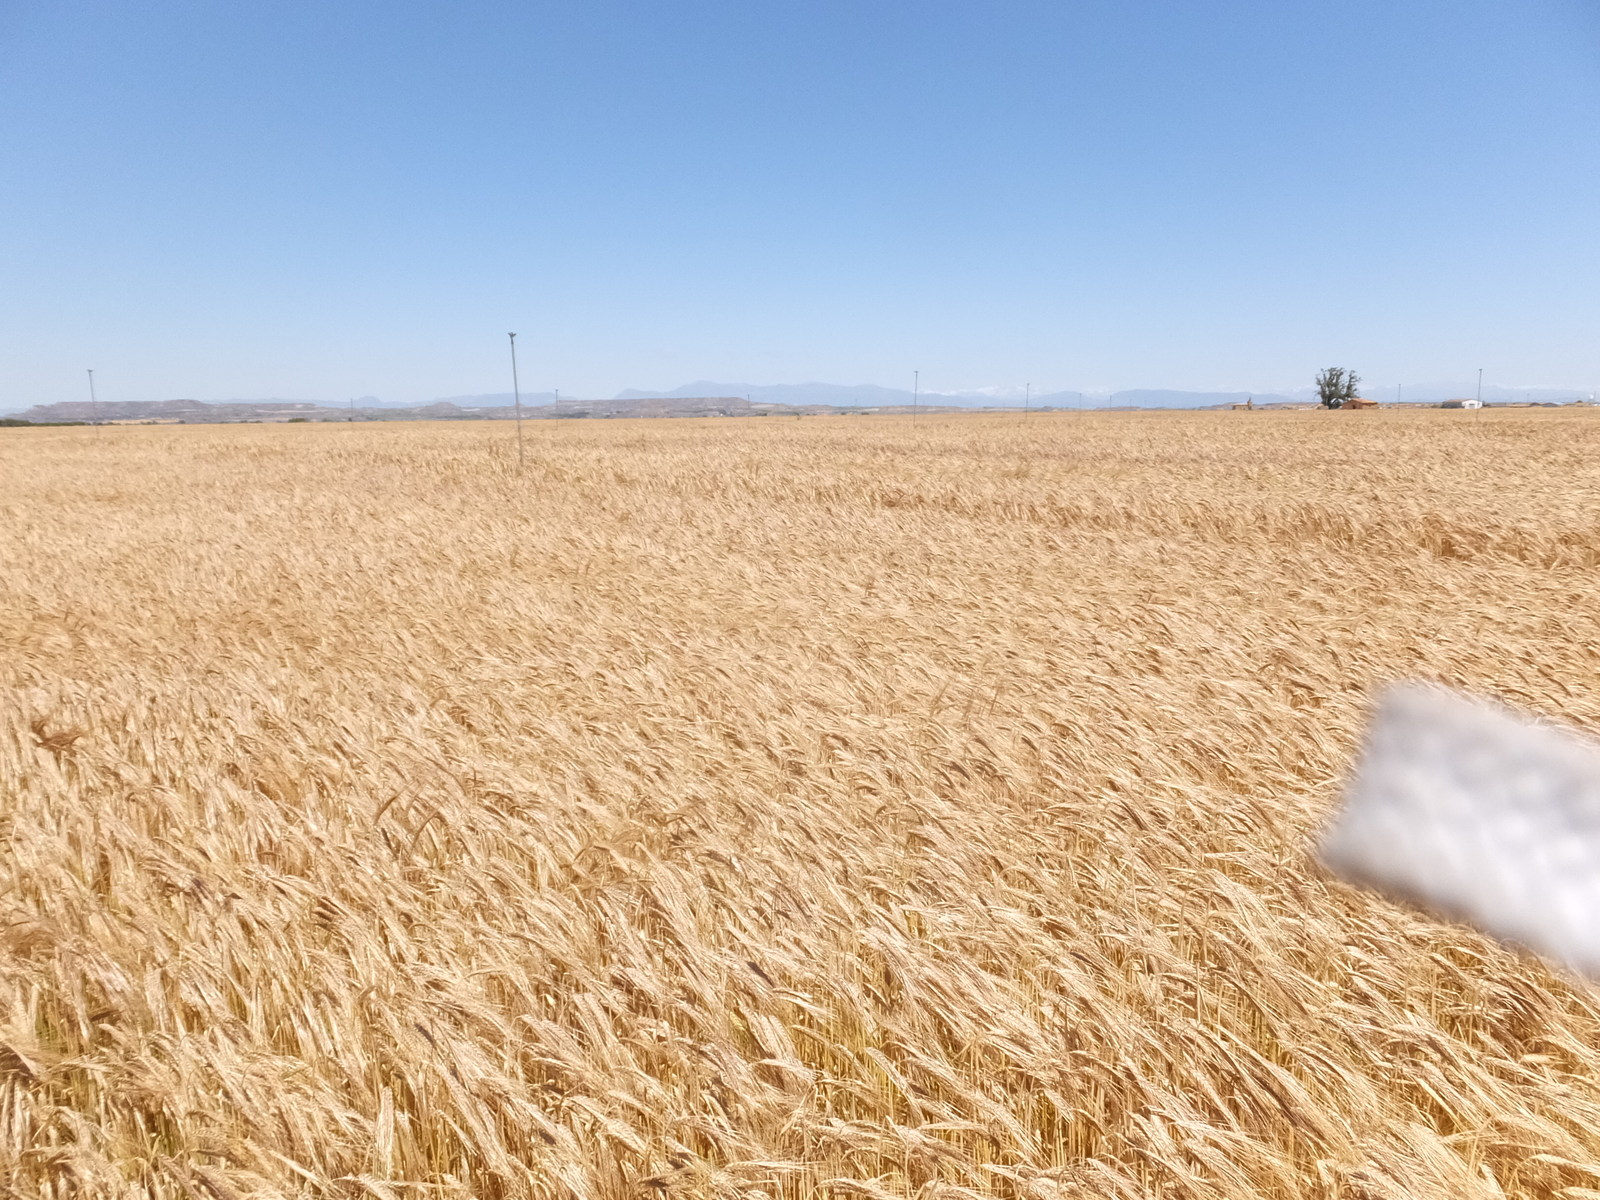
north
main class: Cropland
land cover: Barley
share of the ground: > 75 %
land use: Agriculture (excluding fallow land and kitchen gardens)
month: May
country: ES
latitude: 41.8293
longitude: -0.1929
